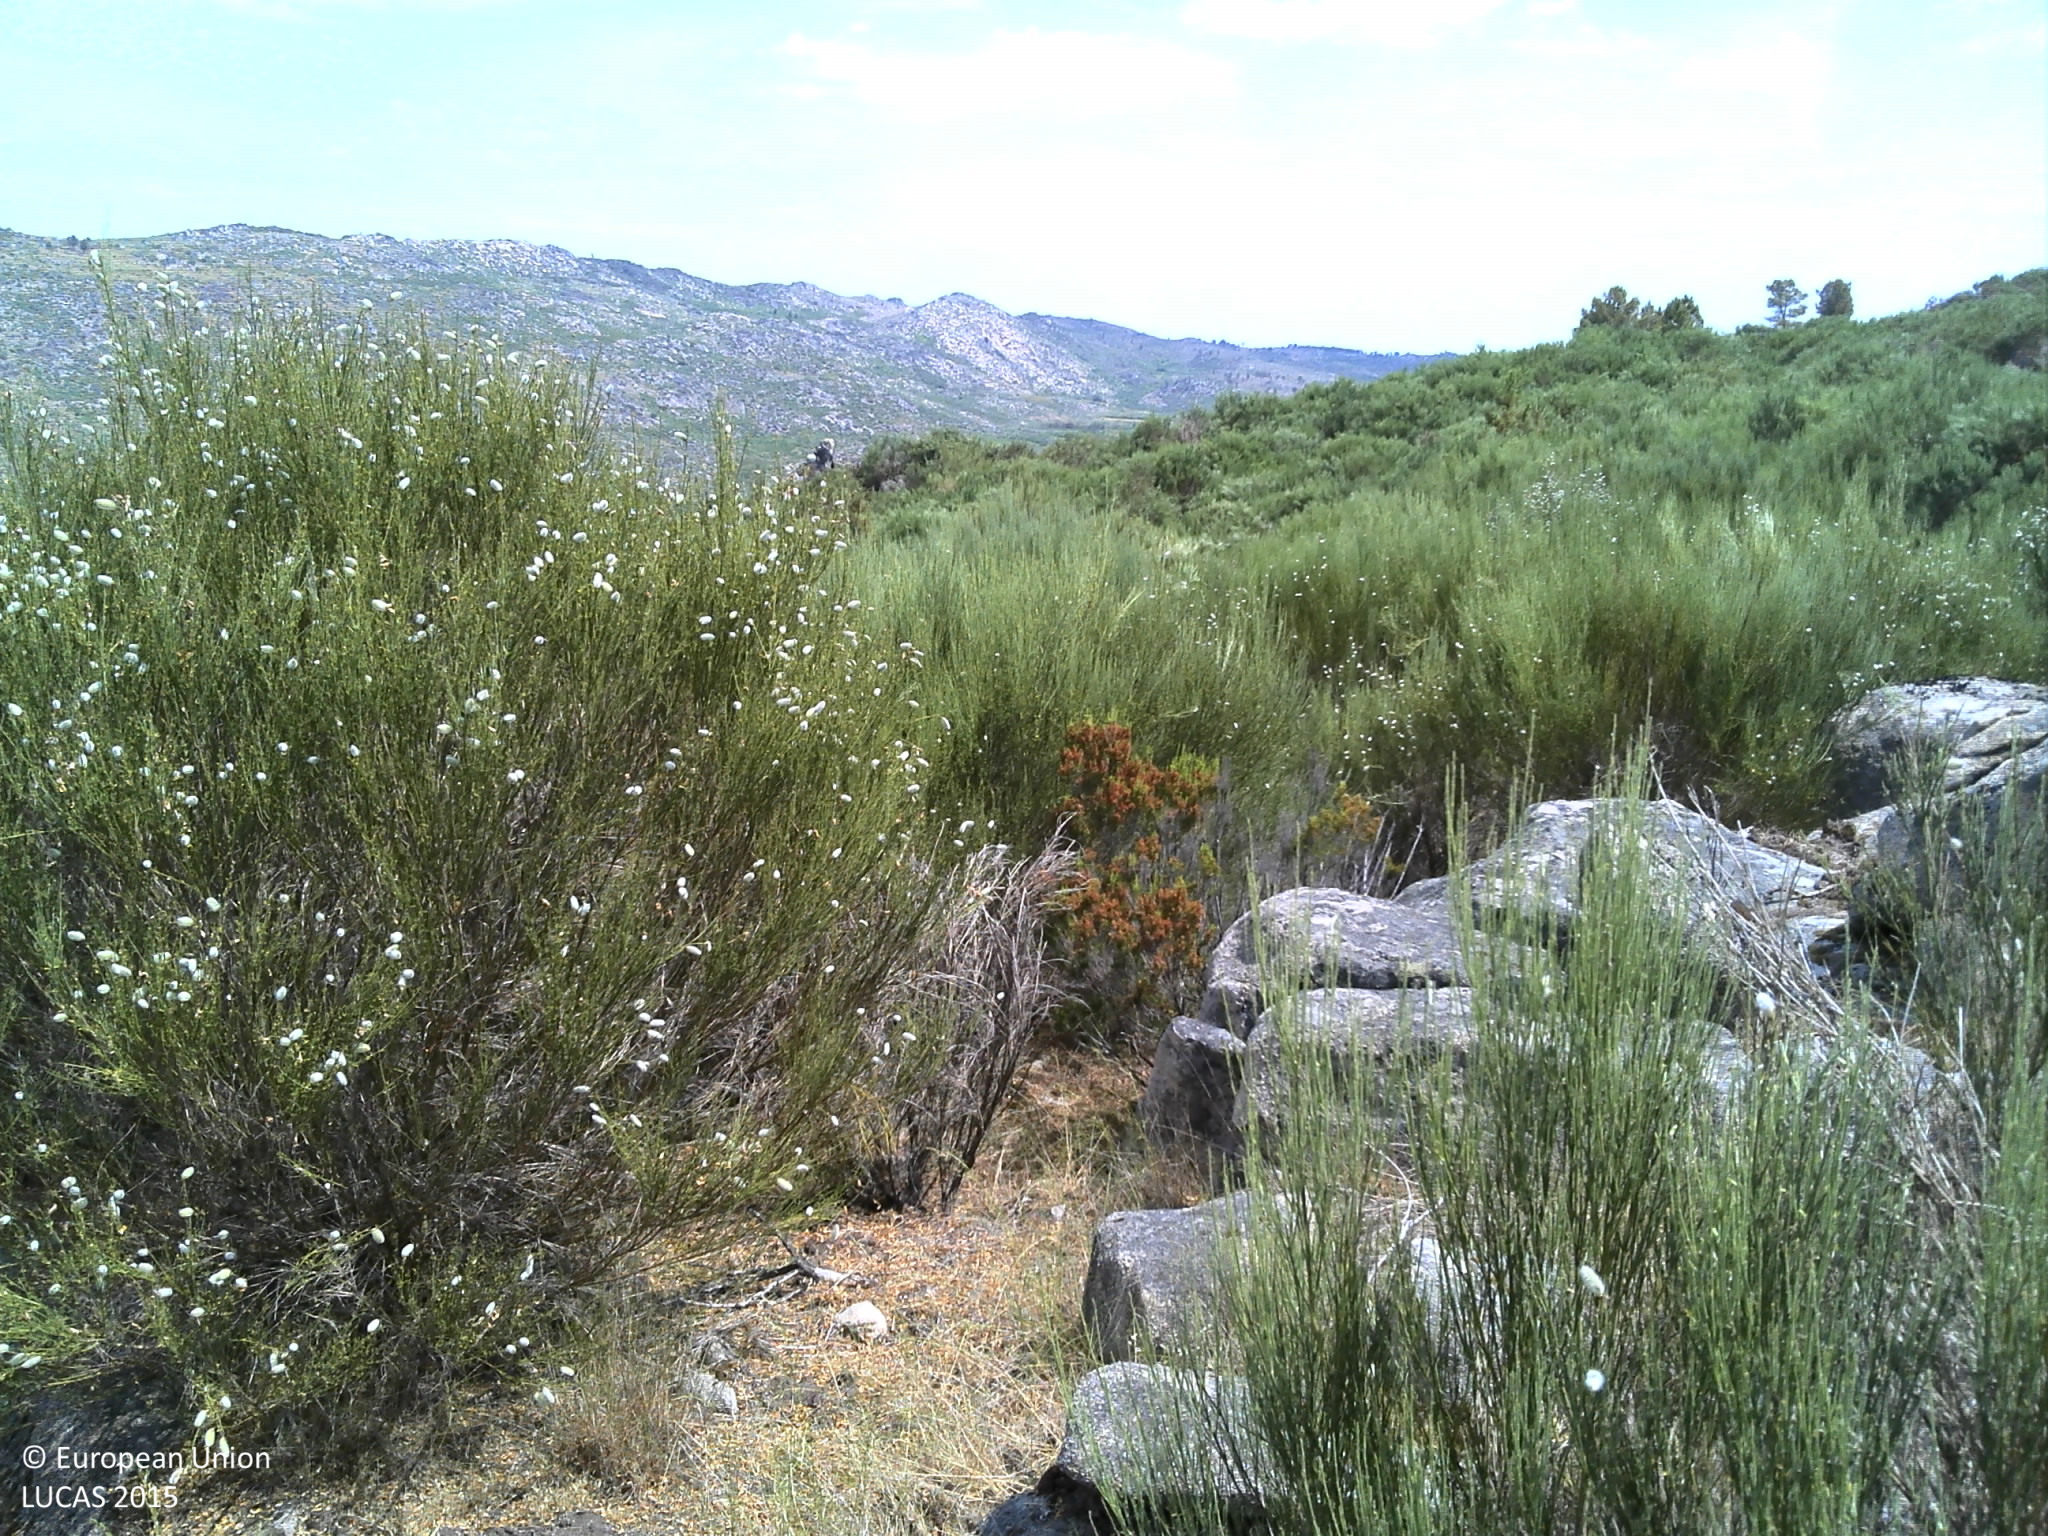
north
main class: Shrubland
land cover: Shrubland without tree cover
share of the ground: > 75 %
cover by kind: shrubs 50 %, consolidated bare surface 45 %, herbaceous plants 5 %
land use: Semi-natural and natural areas not in use
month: June
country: PT
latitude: 41.3975
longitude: -7.5782
